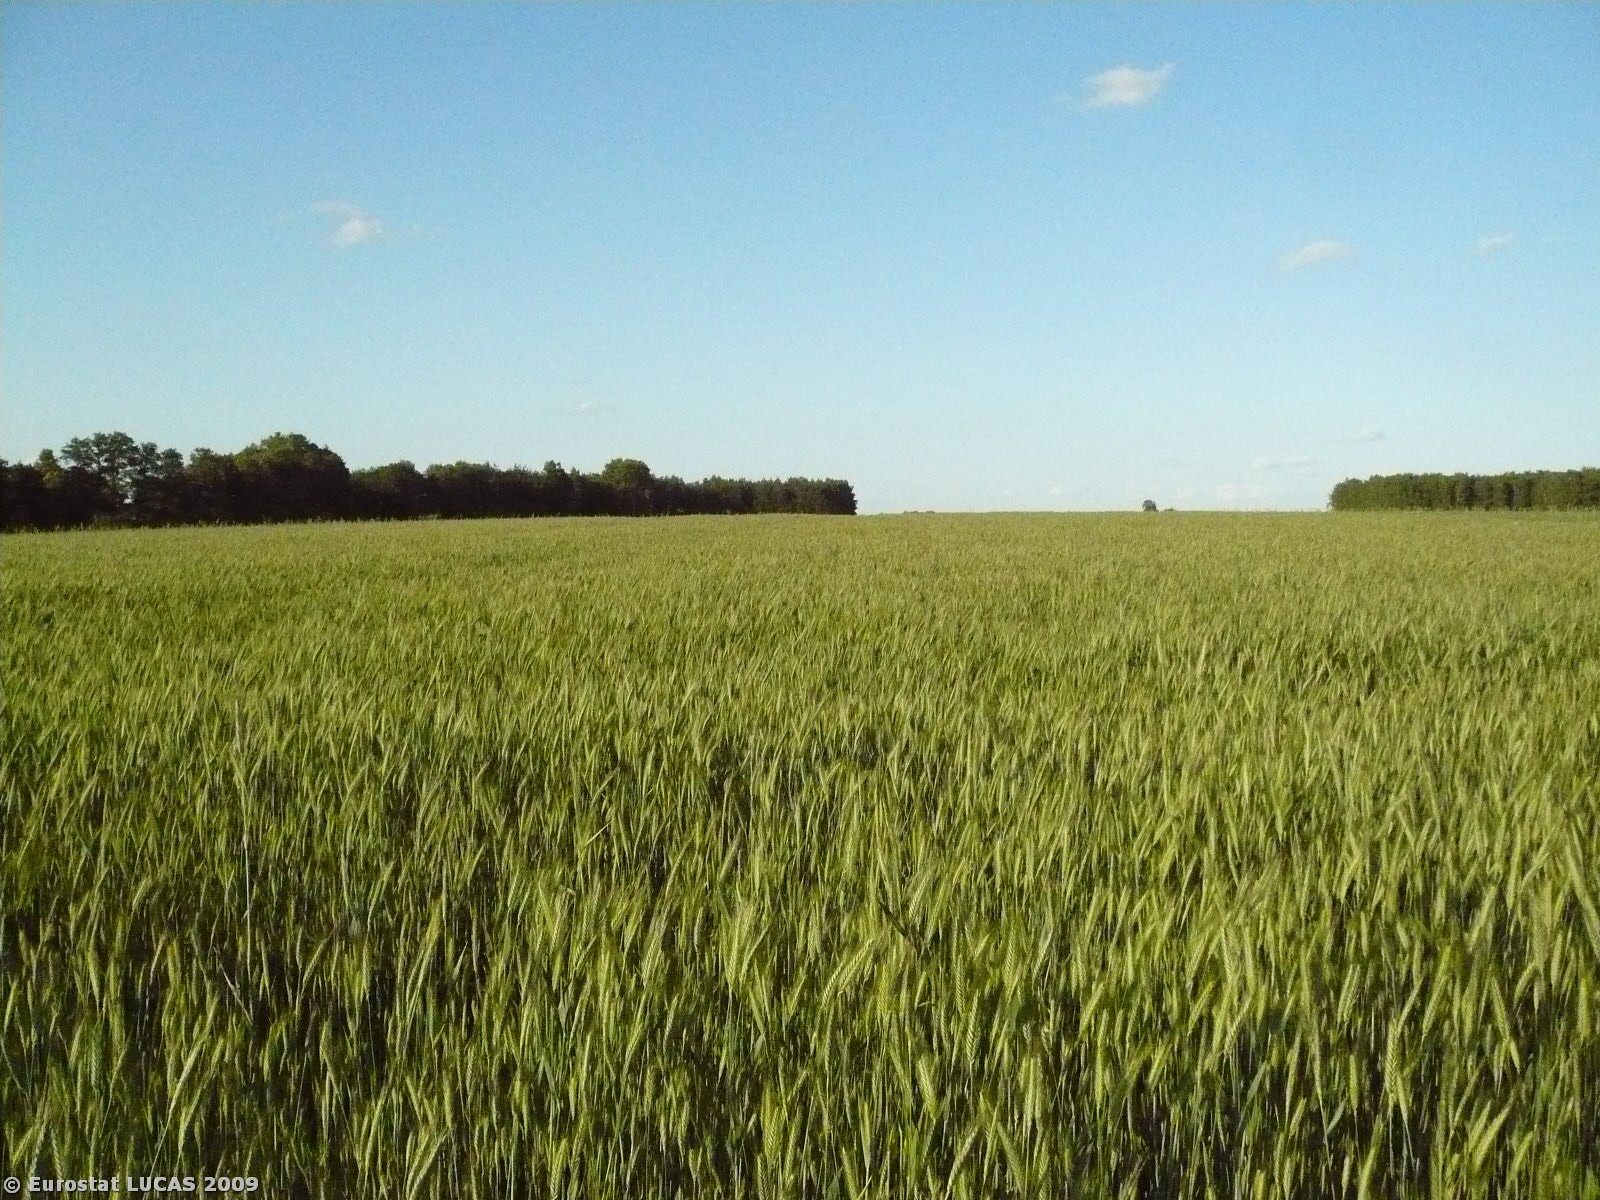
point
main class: Cropland
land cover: Triticale
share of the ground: > 75 %
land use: Agriculture (excluding fallow land and kitchen gardens)
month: May
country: PL
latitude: 52.1378
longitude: 16.3041
